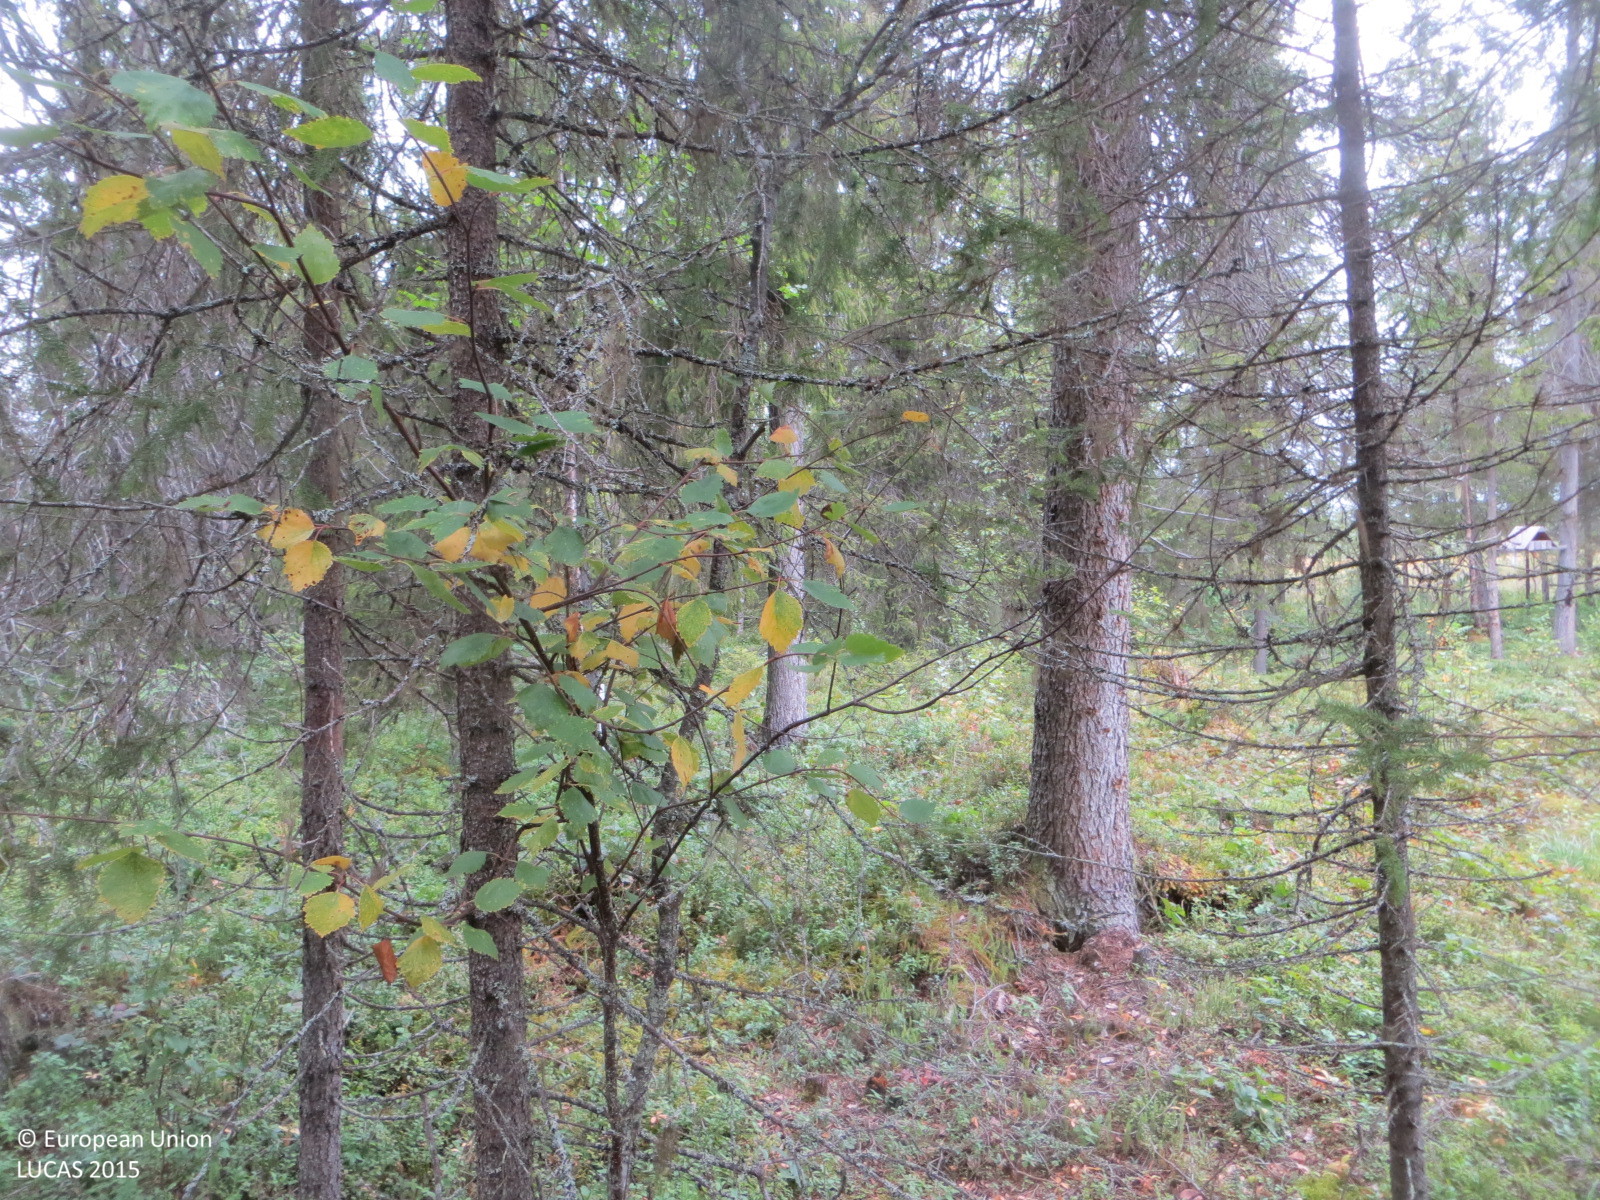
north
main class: Woodland
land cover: Spruce dominated coniferous woodland
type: boreal forest
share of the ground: > 75 %
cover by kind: coniferous forest trees 75 %, shrubs 25 %
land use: Forestry
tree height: > 5 m
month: August
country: FI
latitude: 67.5331
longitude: 24.2600
